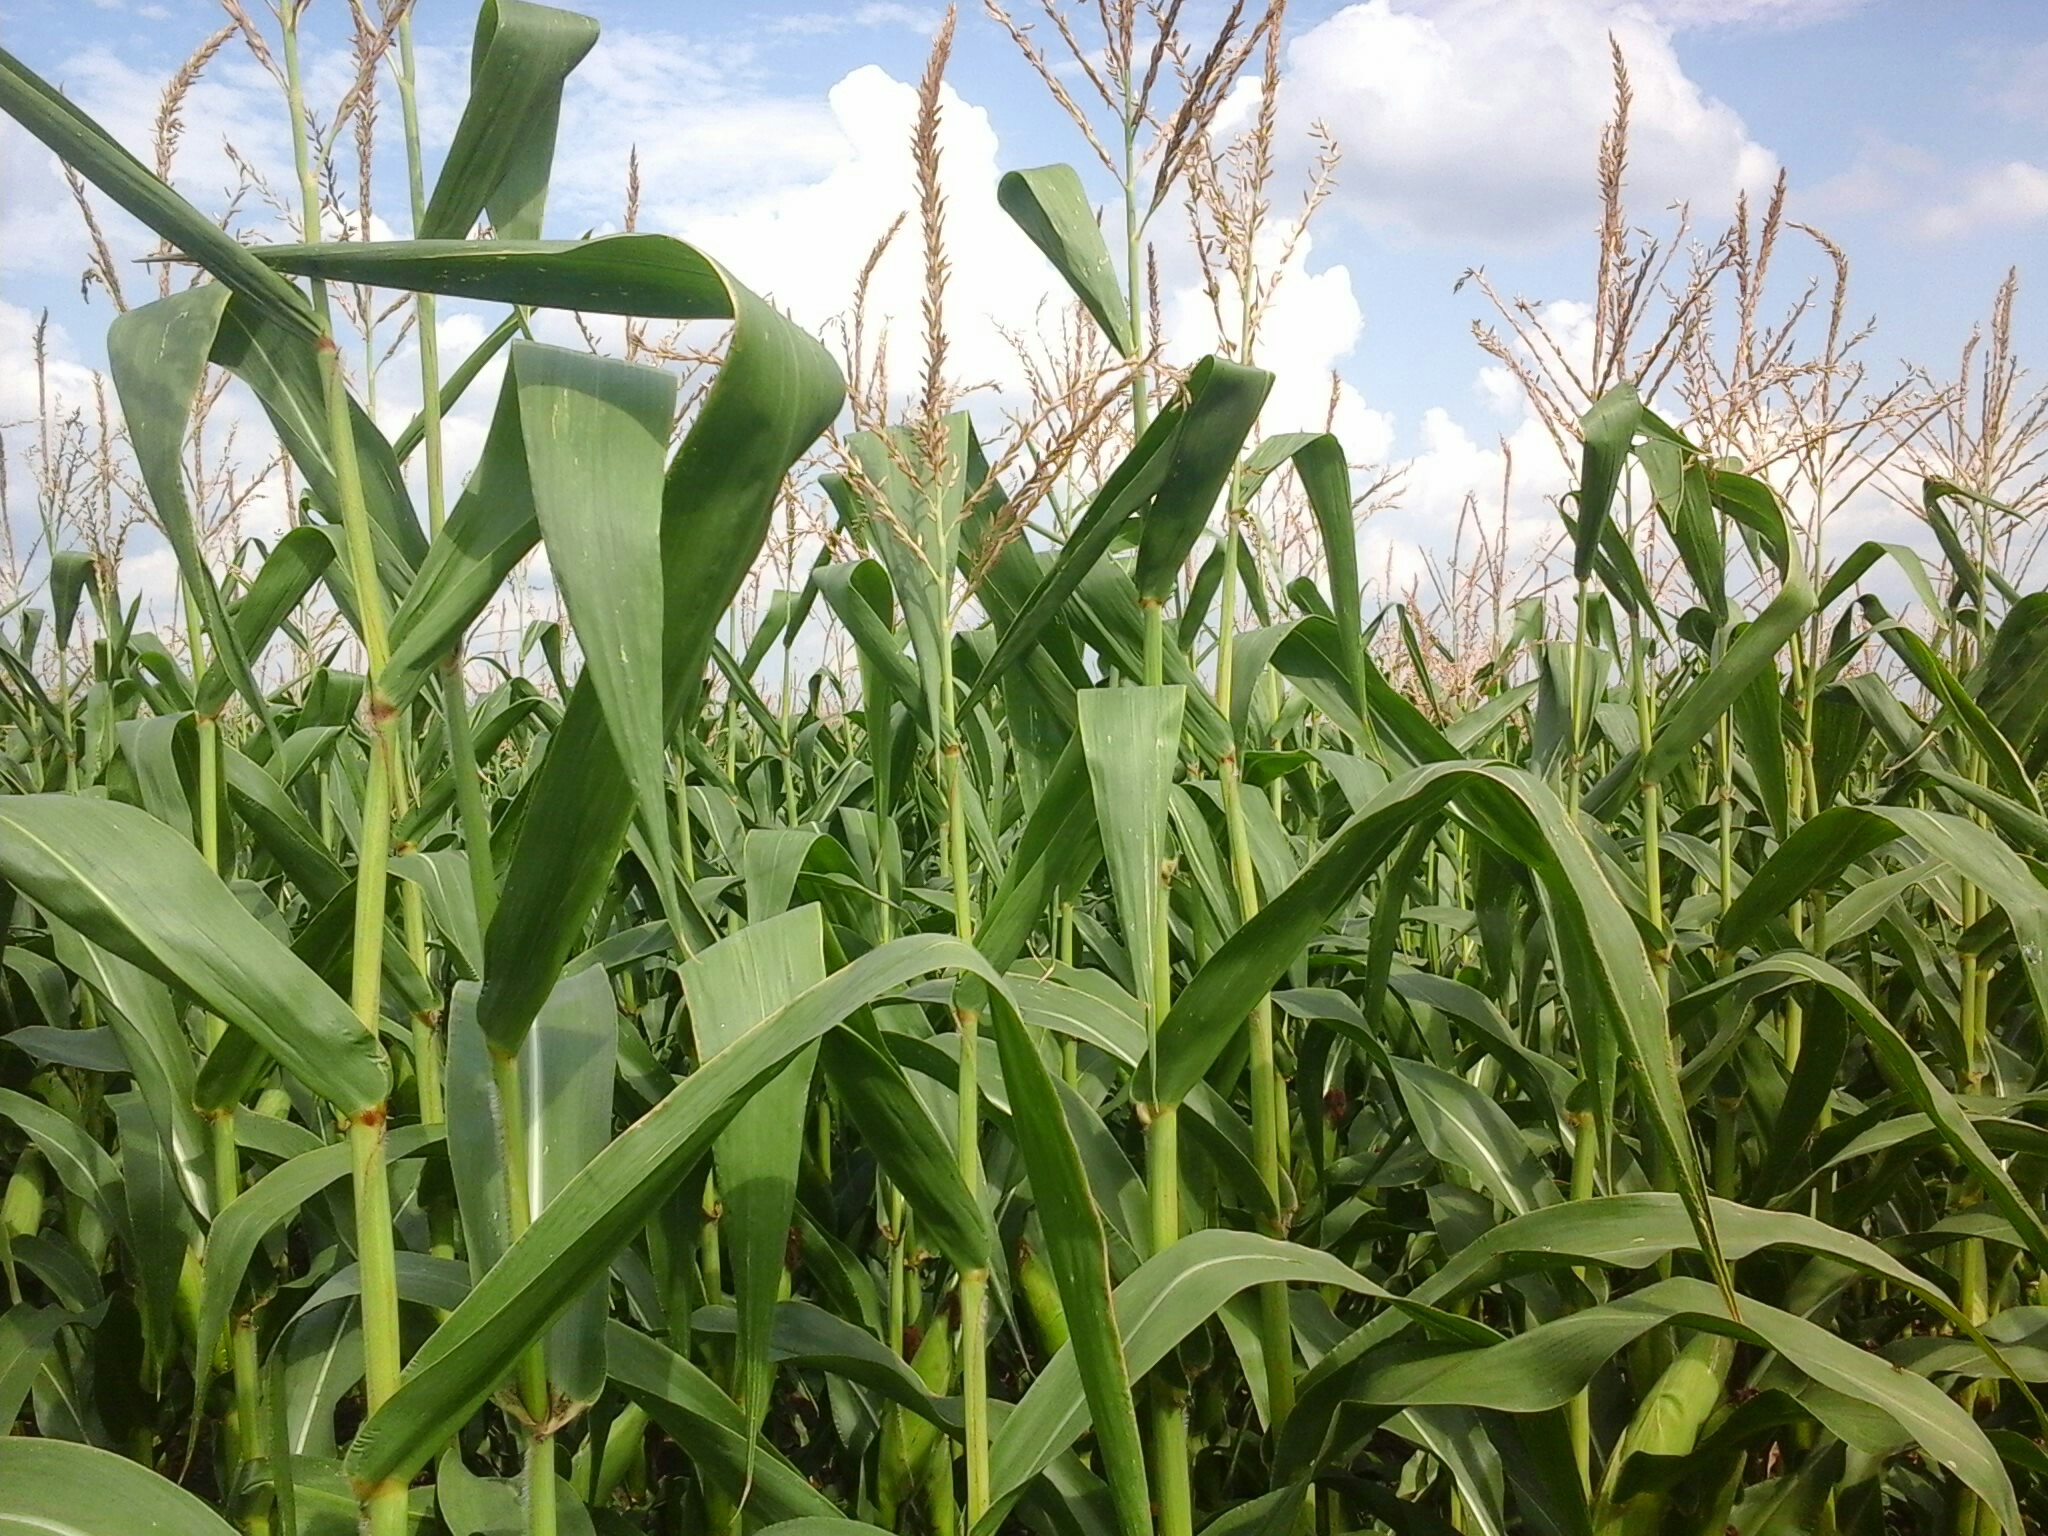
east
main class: Cropland
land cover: Maize
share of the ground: > 75 %
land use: Agriculture (excluding fallow land and kitchen gardens)
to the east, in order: Maize; Tracks; Maize
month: August
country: HU
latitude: 47.5372
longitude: 18.2087
